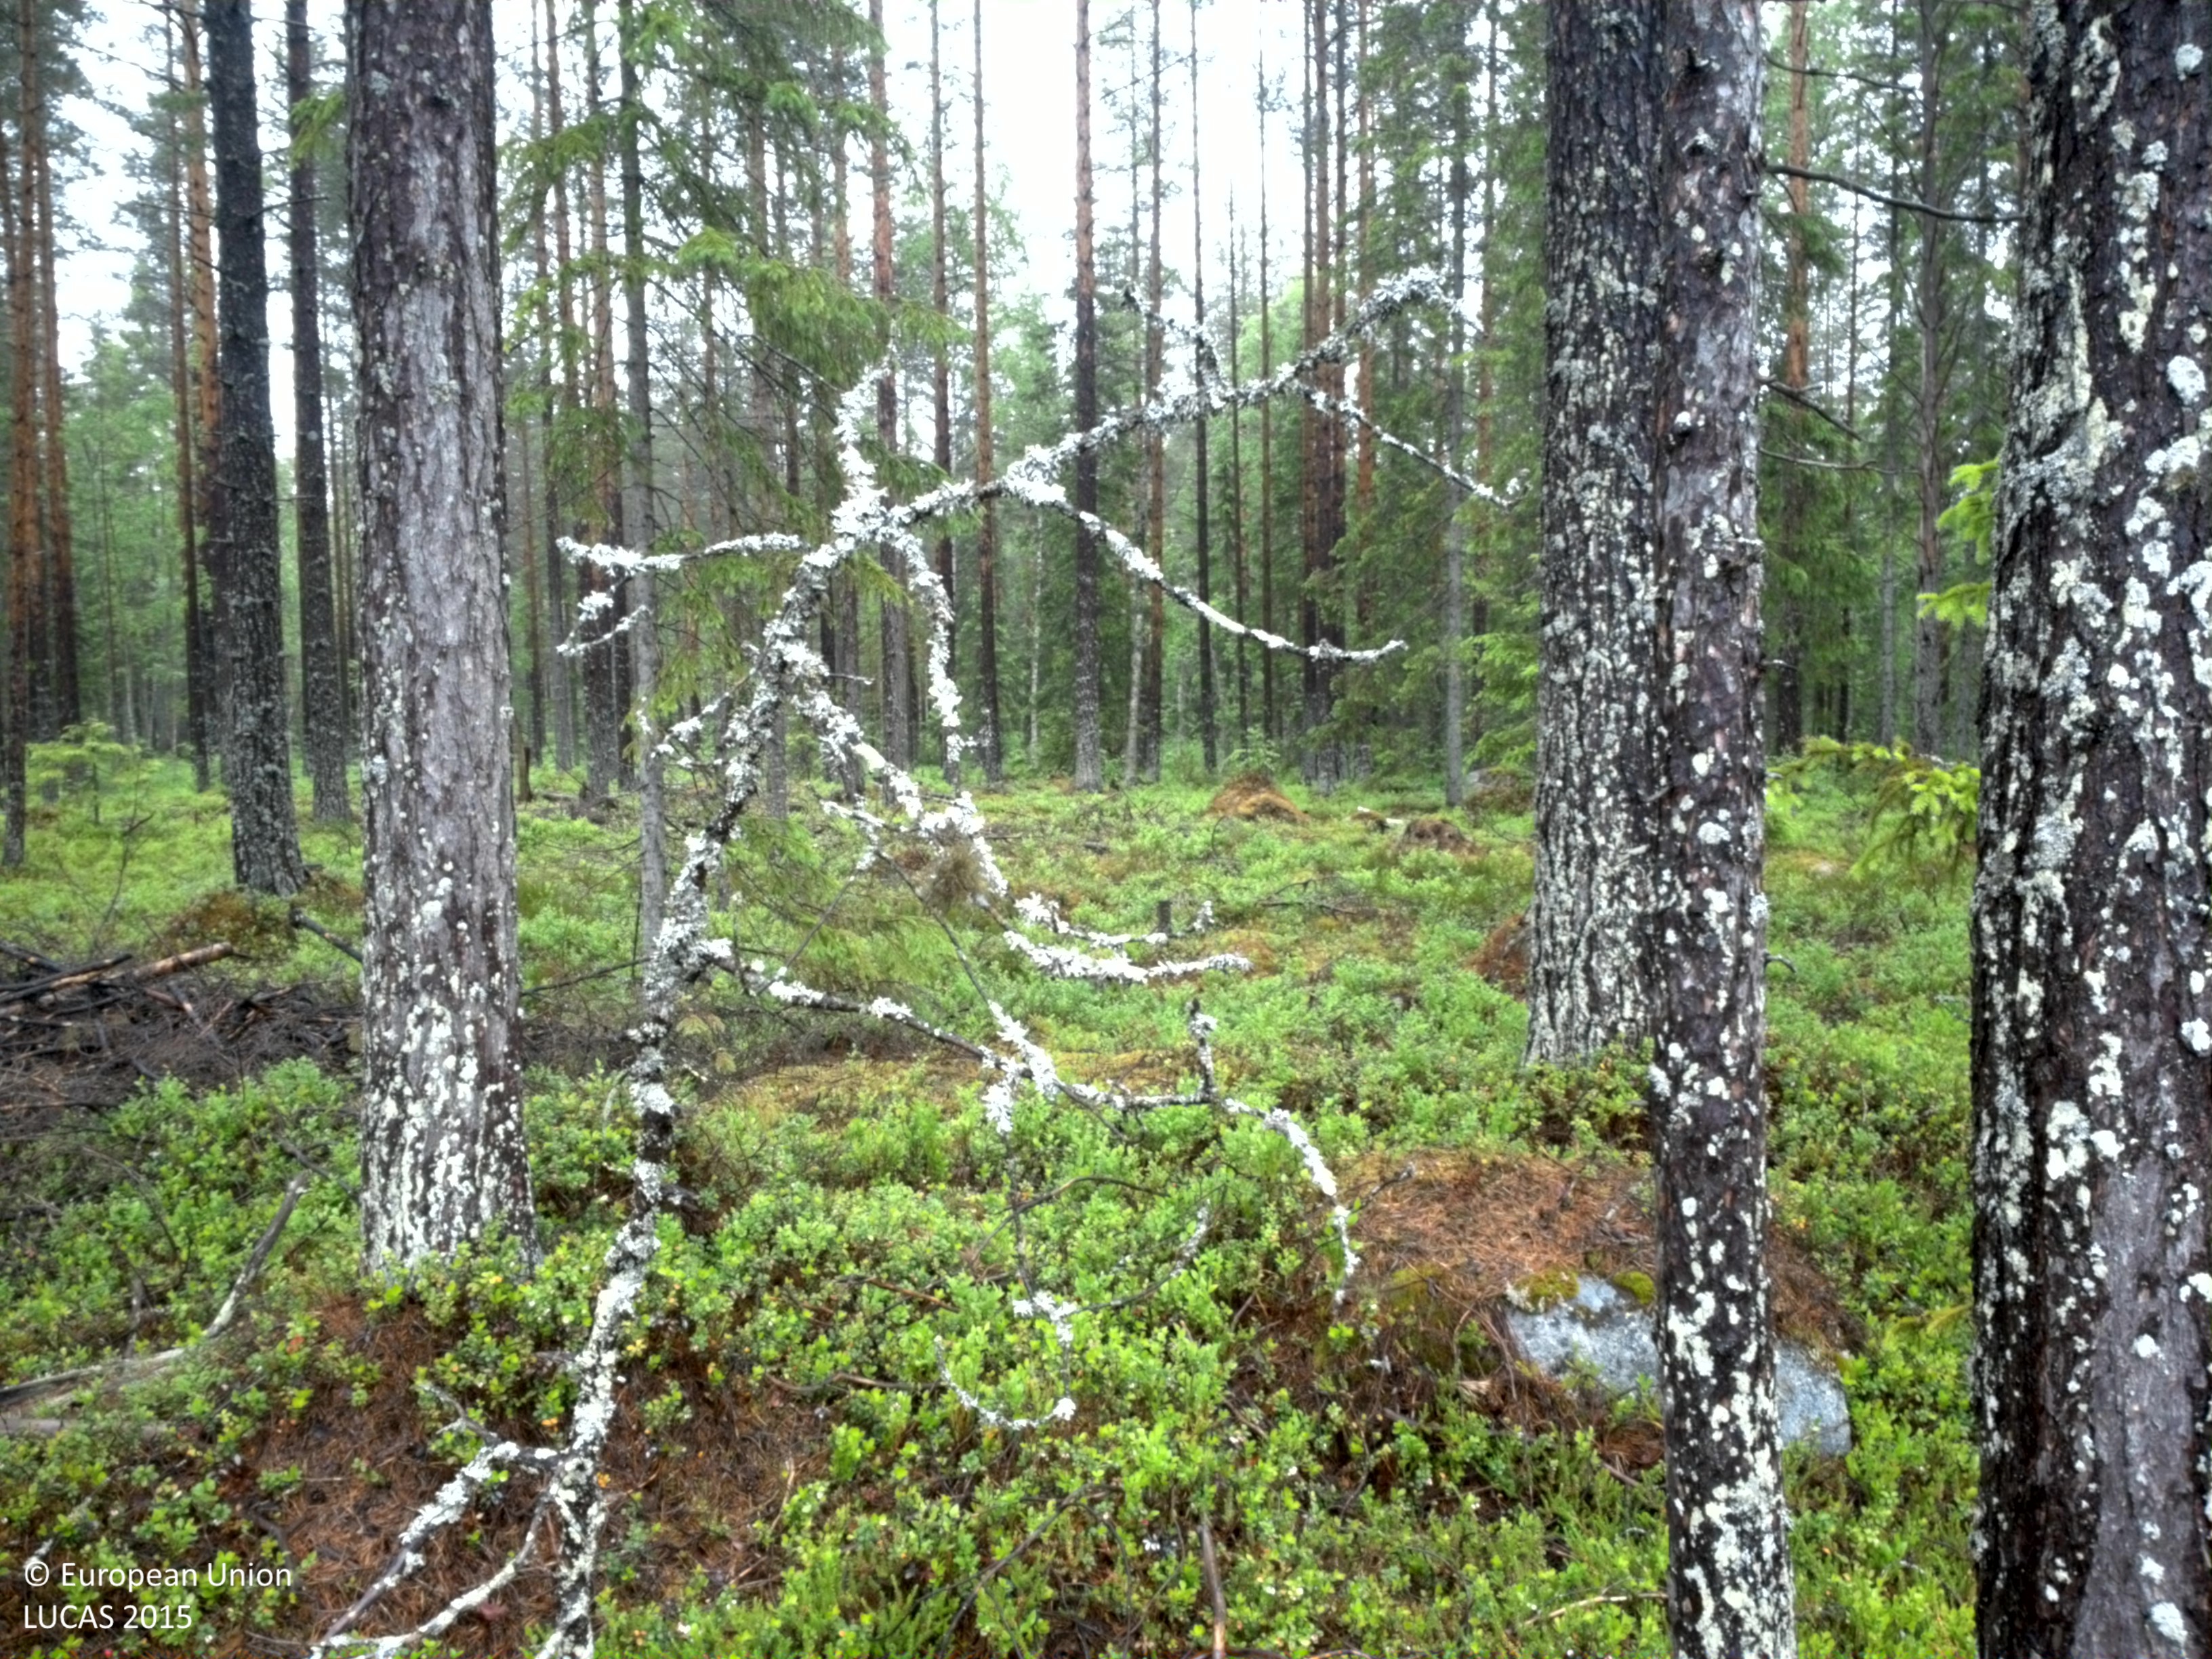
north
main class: Woodland
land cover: Other coniferous woodland
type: boreal forest
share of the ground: 50 - 75 %
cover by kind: coniferous forest trees 60 %, shrubs 20 %, broadleaved forest trees 15 %, lichens and mosses 5 %
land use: Forestry
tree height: > 5 m
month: June
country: SE
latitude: 64.3511
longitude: 20.8935
